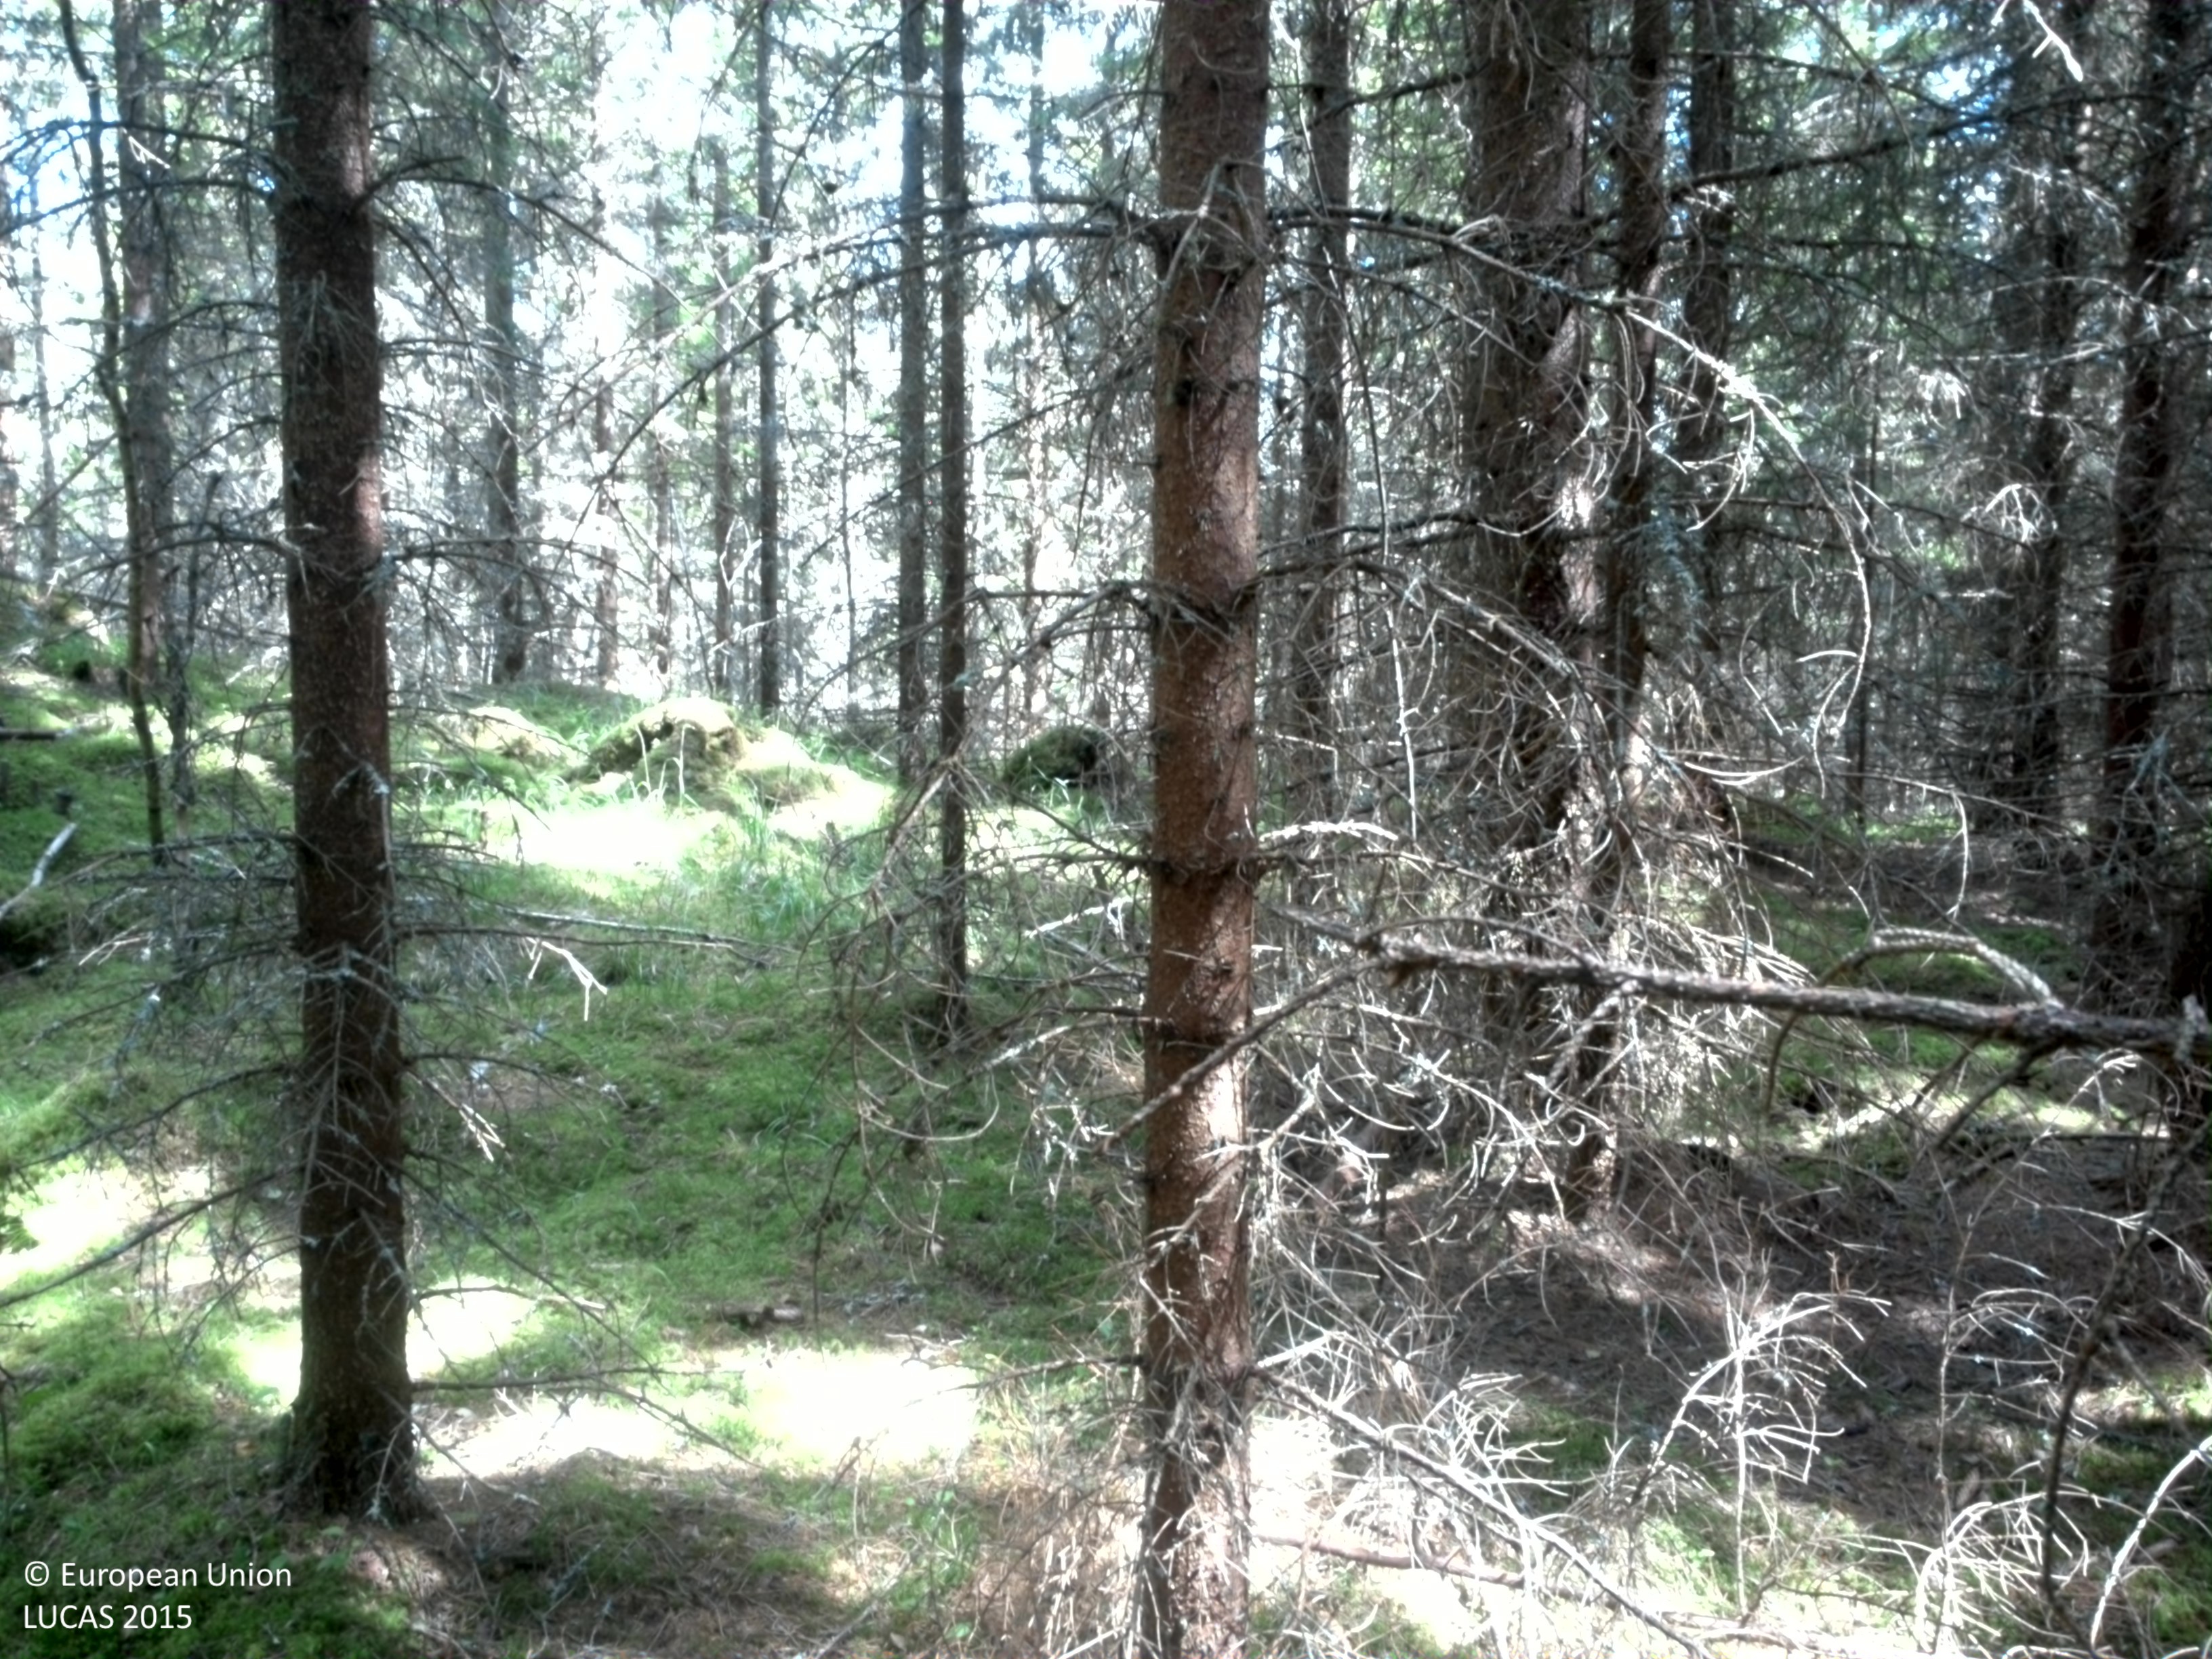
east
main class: Woodland
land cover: Spruce dominated coniferous woodland
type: boreal forest
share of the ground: > 75 %
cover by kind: coniferous forest trees 85 %, lichens and mosses 15 %
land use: Forestry
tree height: > 5 m
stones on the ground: > 50 %
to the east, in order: Spruce dominated coniferous woodland; Spruce dominated mixed woodland; Ditches and canals; Paved roads, cycling and walking lanes; Spruce dominated mixed woodland; Pine dominated coniferous woodland
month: July
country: SE
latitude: 59.6159
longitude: 14.6877
